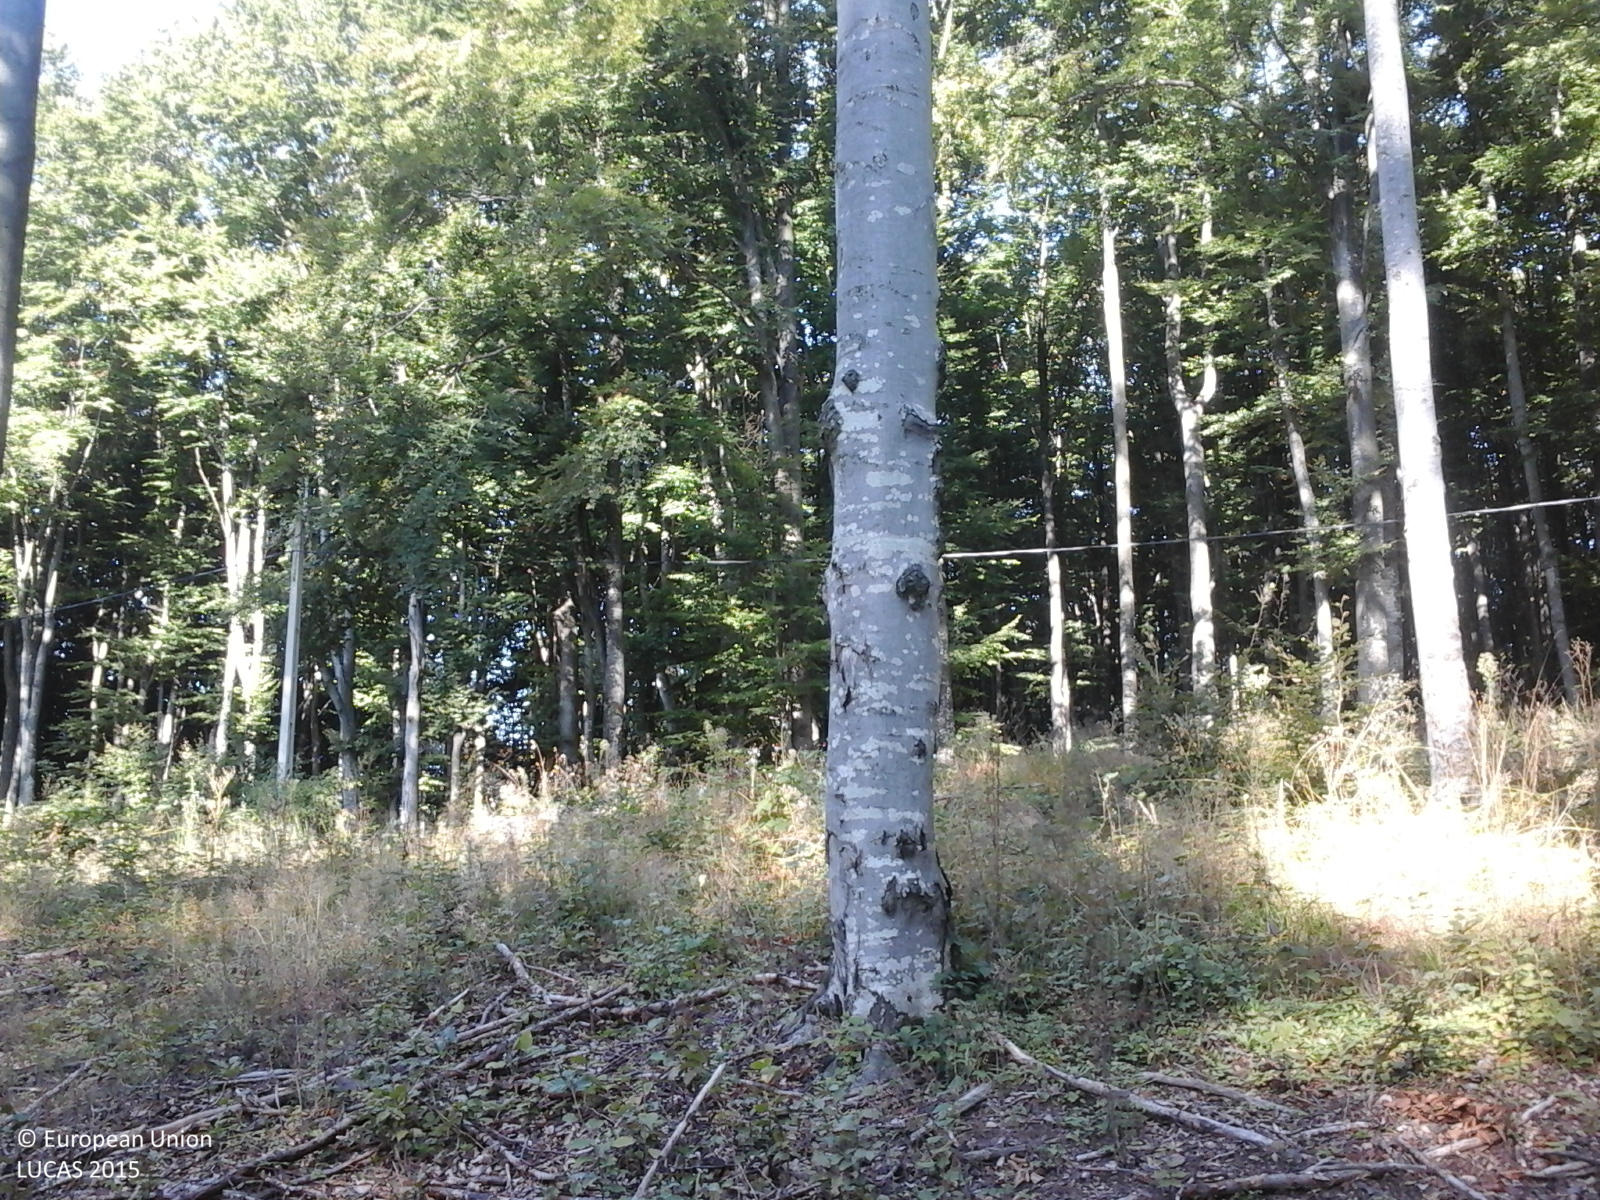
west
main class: Woodland
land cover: Broadleaved woodland
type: beech forest
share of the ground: > 75 %
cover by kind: broadleaved forest trees 100 %
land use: Forestry
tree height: > 5 m
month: September
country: RO
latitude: 47.1310
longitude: 22.4599
